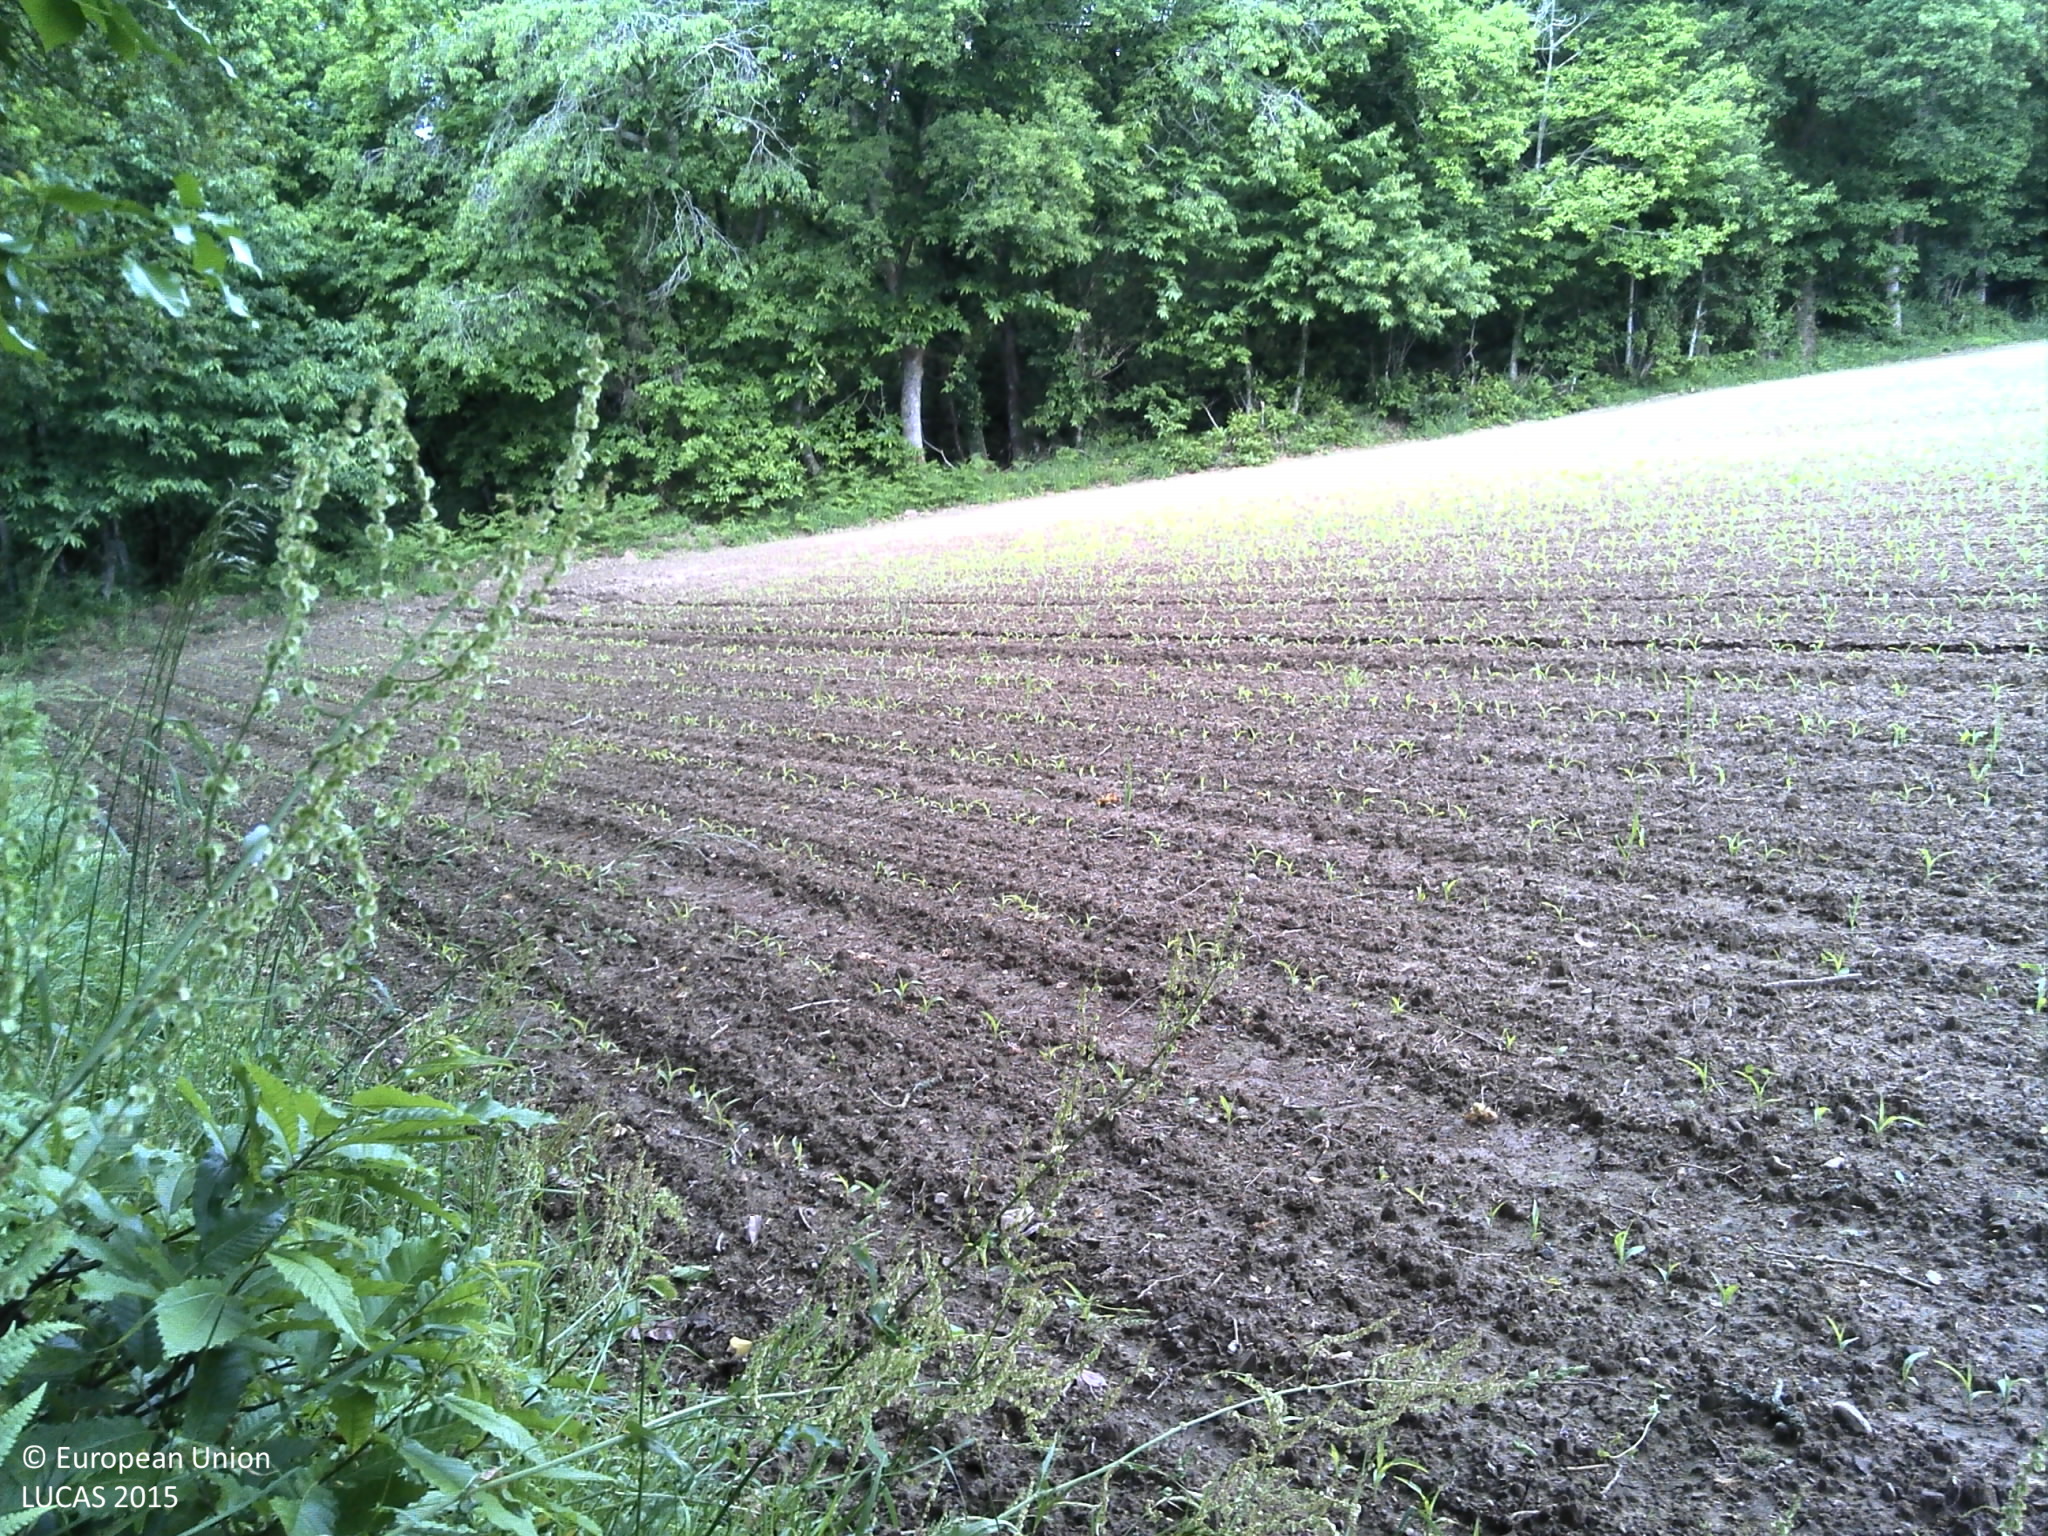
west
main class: Cropland
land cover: Maize
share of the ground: 10 - 25 %
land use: Agriculture (excluding fallow land and kitchen gardens)
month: June
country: FR
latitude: 47.8163
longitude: -3.5794
